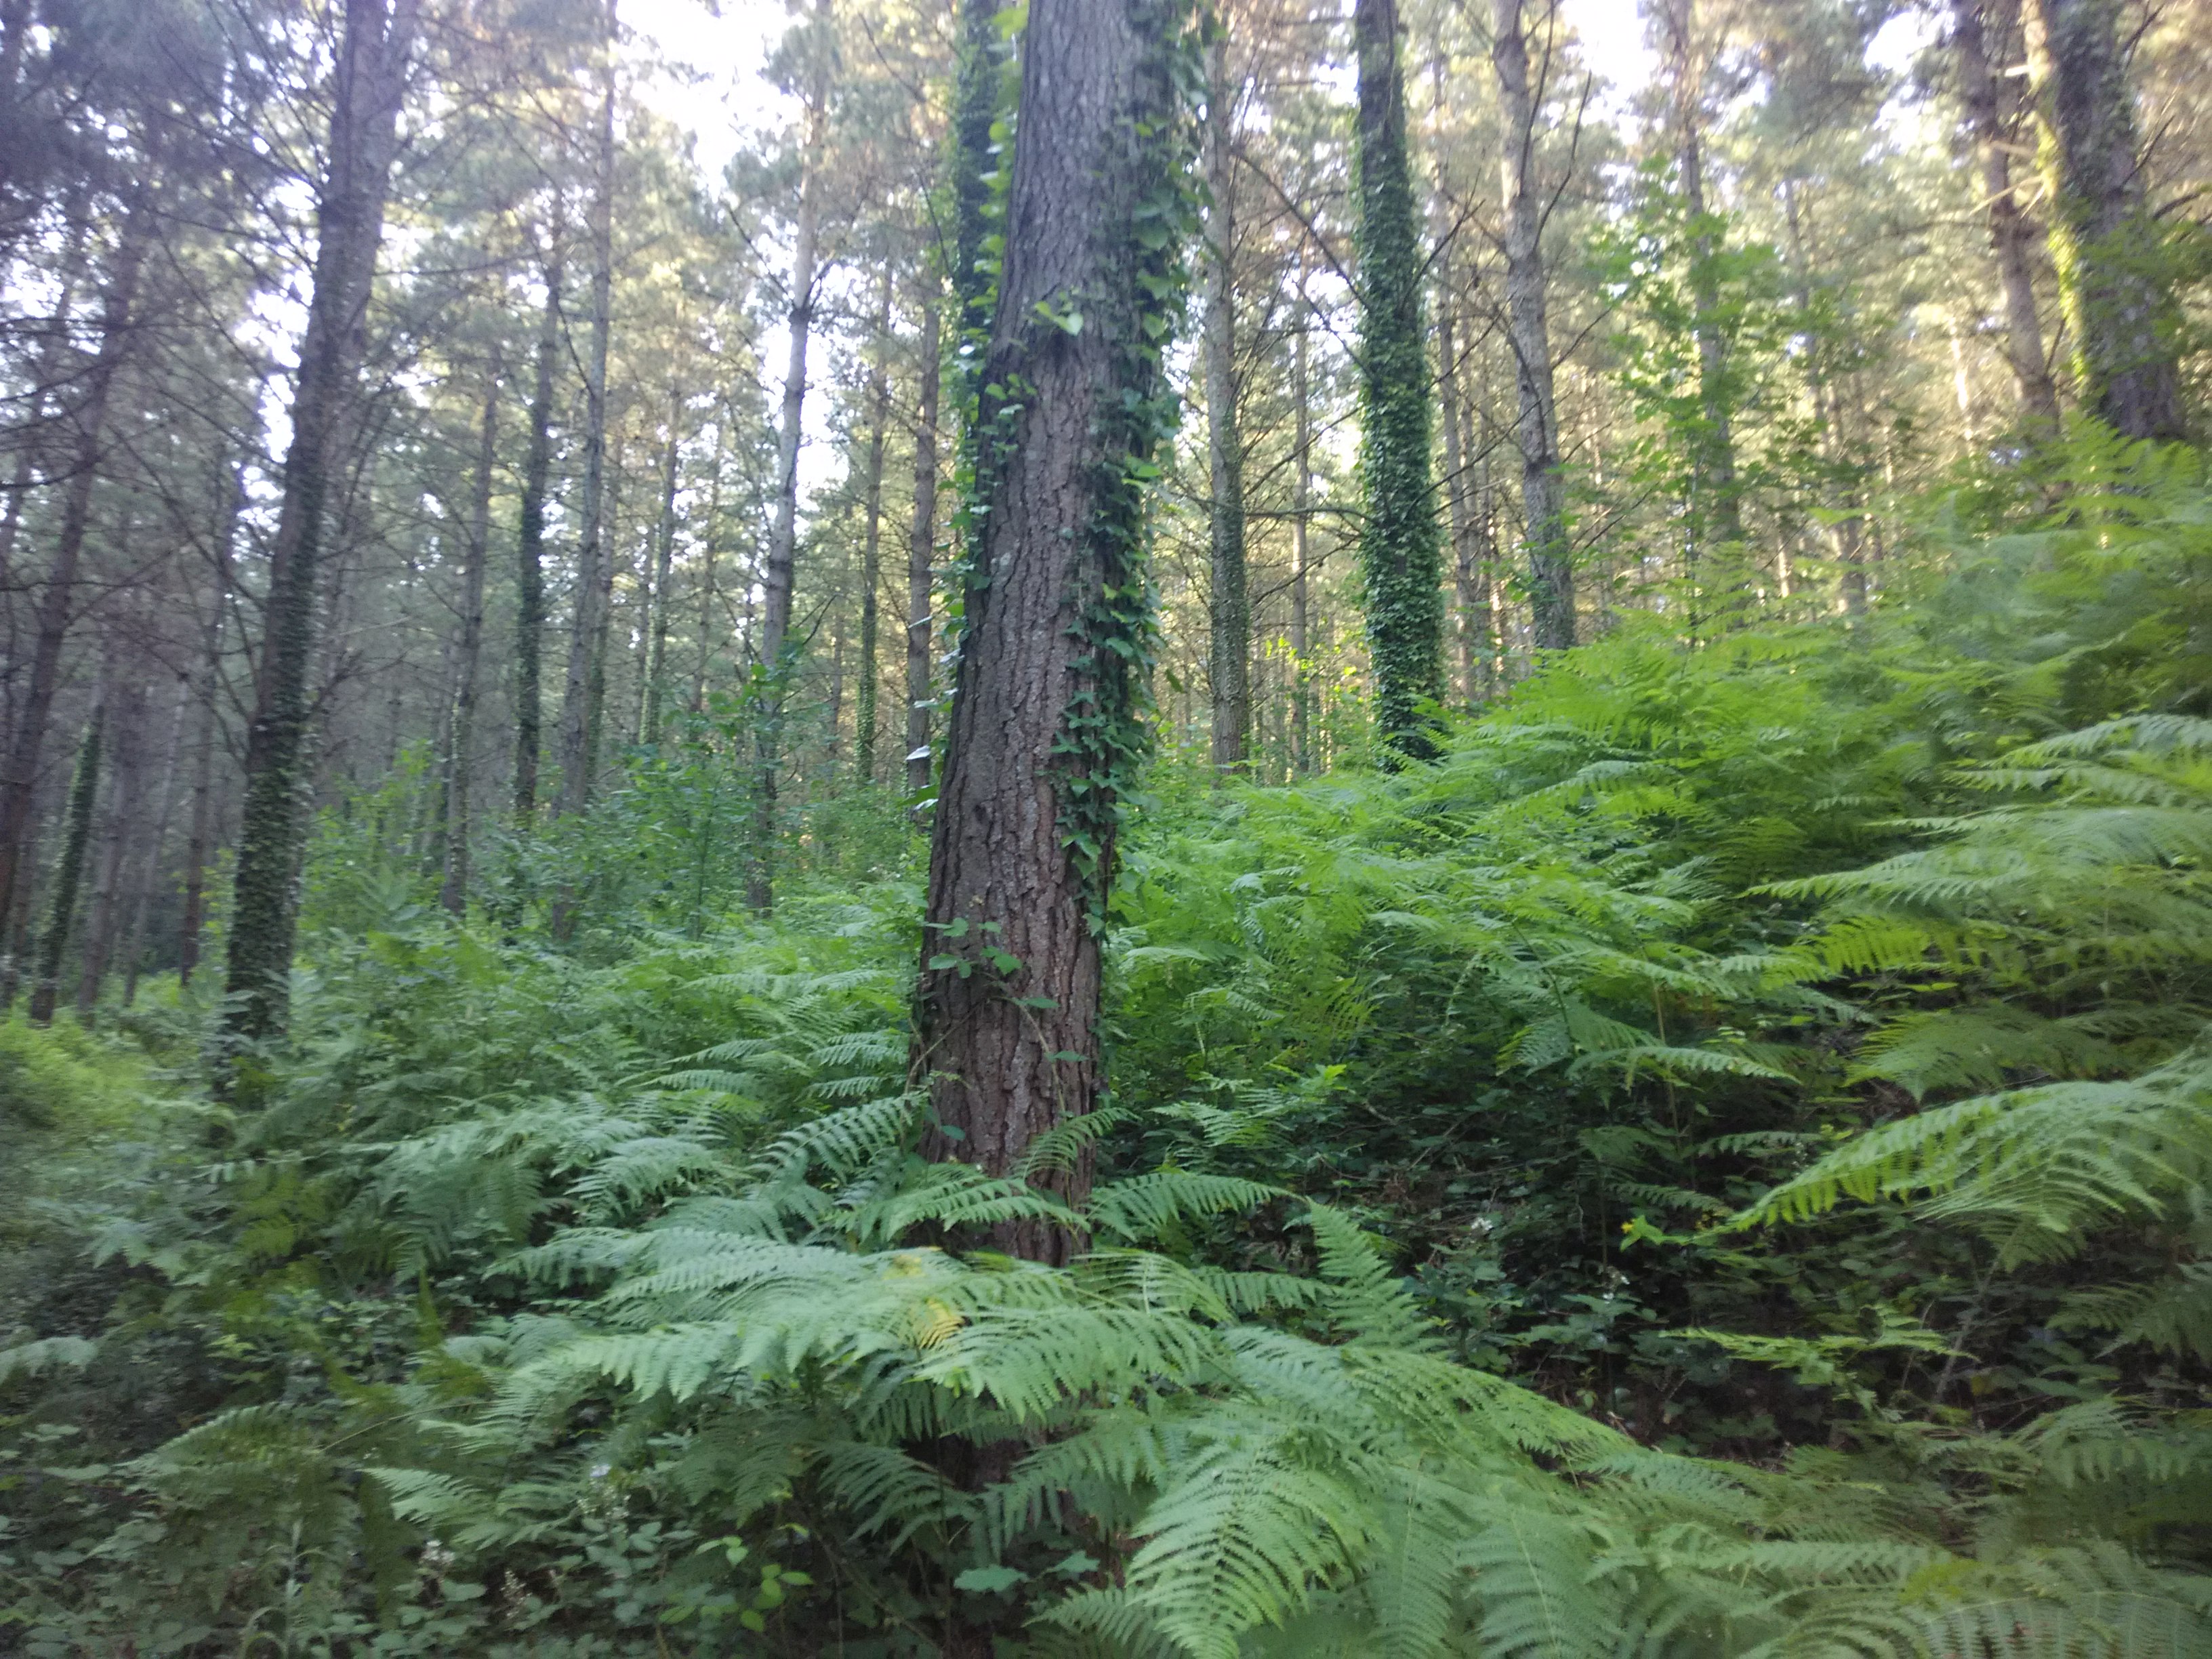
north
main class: Woodland
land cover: Pine dominated coniferous woodland
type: exotic forest
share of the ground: > 75 %
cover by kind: coniferous forest trees 90 %, broadleaved forest trees 10 %
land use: Forestry
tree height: > 5 m
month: June
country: ES
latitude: 43.0755
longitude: -2.5424
